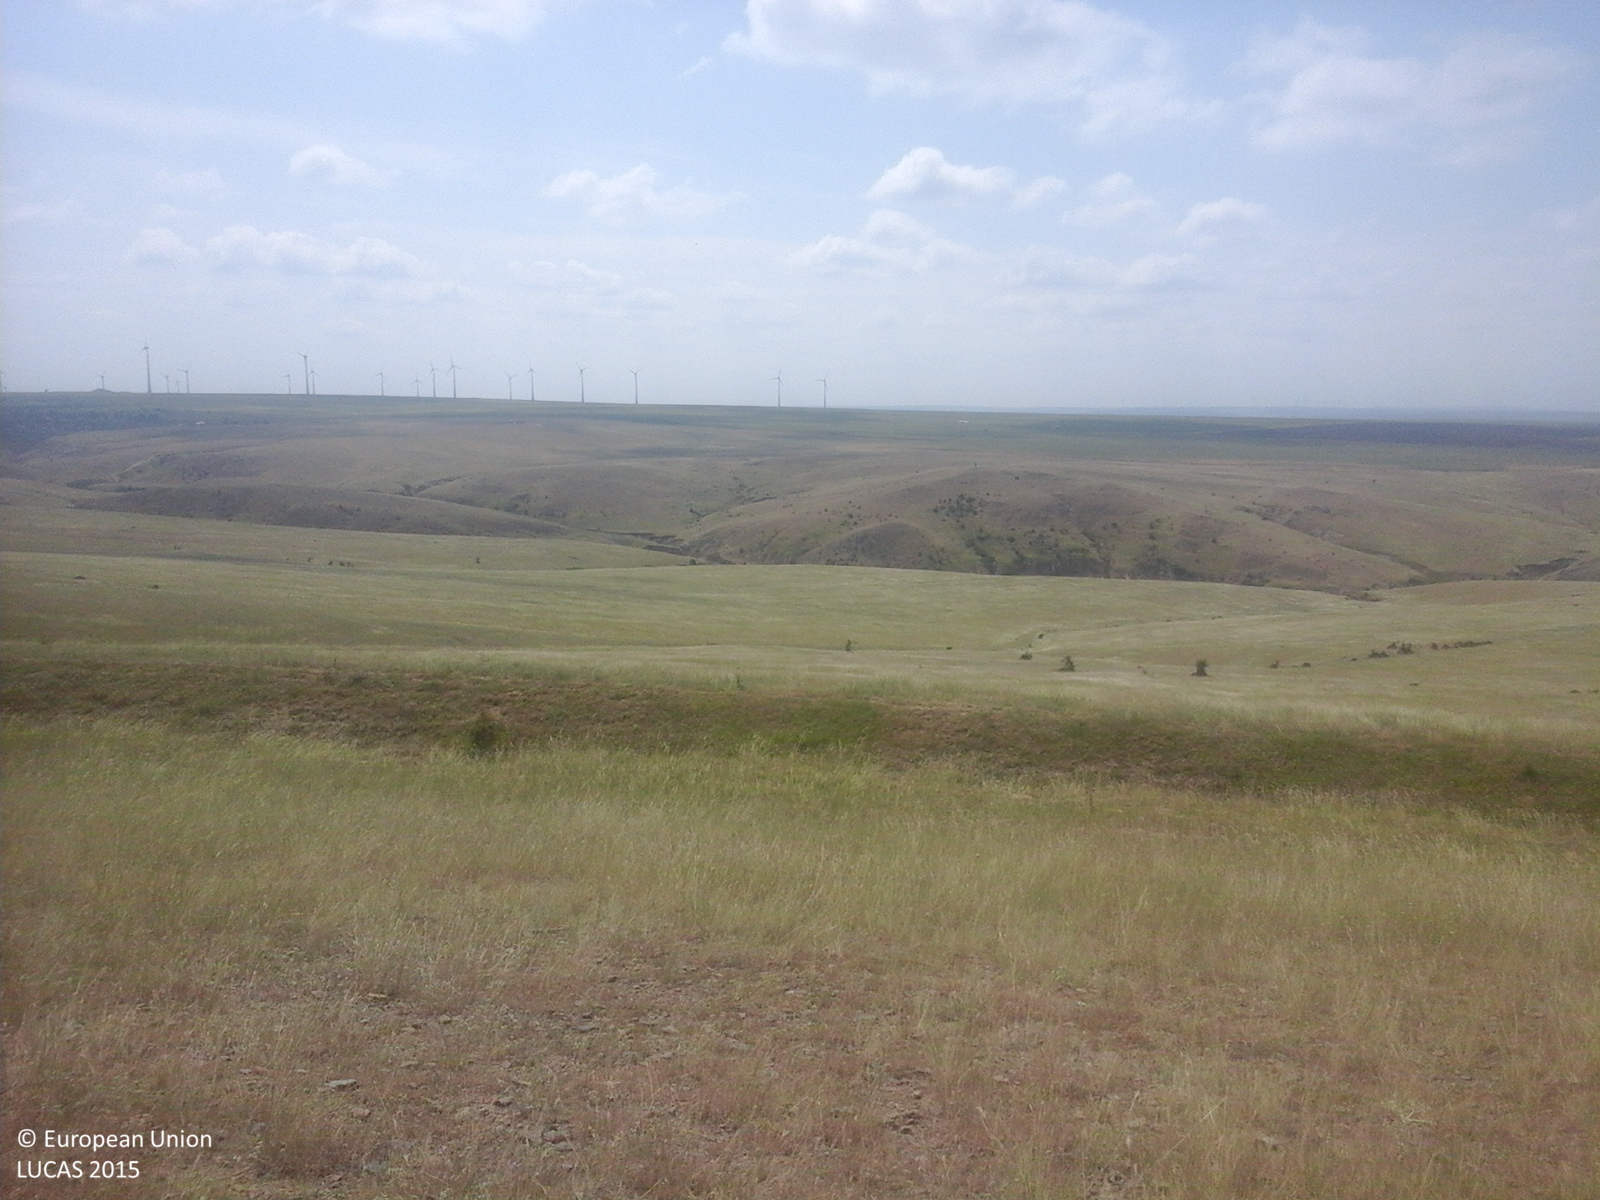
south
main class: Grassland
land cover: Grassland without tree/shrub cover
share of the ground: > 75 %
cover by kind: herbaceous plants 90 %, unconsolidated bare surface 10 %
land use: Agriculture (excluding fallow land and kitchen gardens)
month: August
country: RO
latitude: 44.7508
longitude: 28.3221
